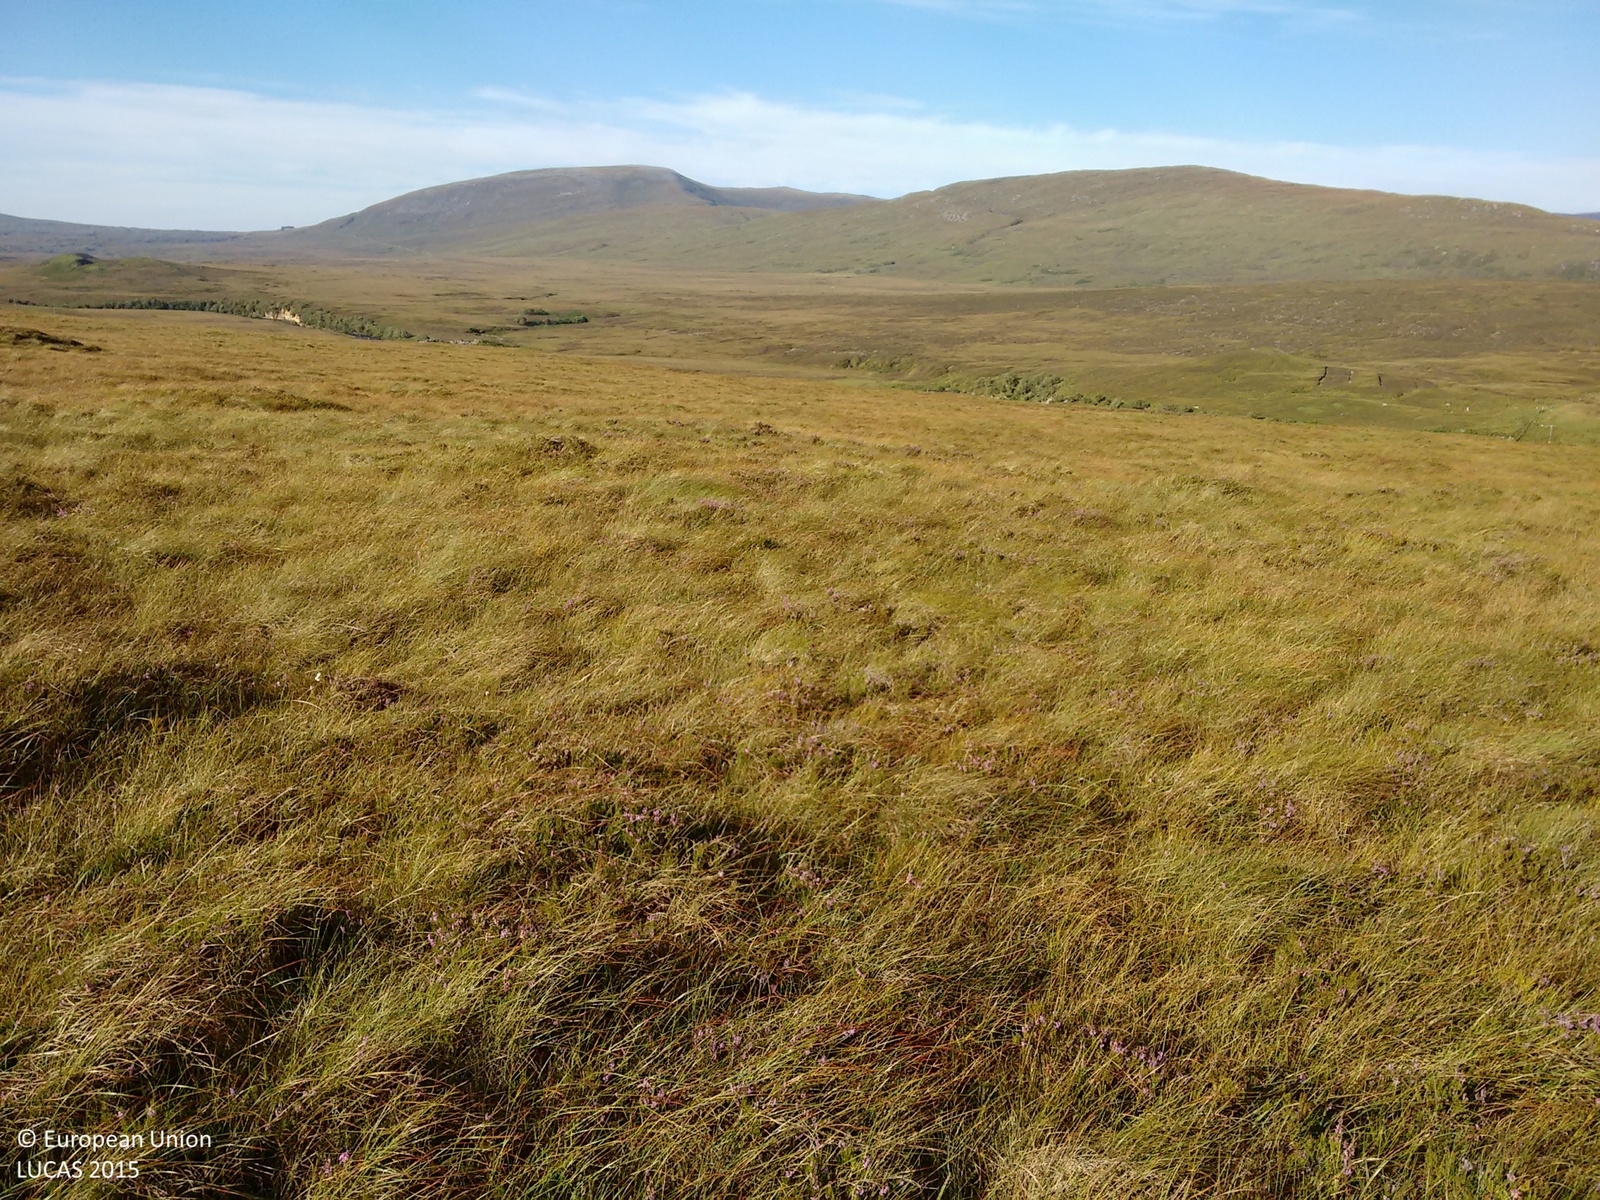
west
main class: Shrubland
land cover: Shrubland without tree cover
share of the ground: 25 - 50 %
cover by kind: herbaceous plants 70 %, shrubs 30 %
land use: Agriculture (excluding fallow land and kitchen gardens)
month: September
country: GB
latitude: 58.5121
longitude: -4.8023
